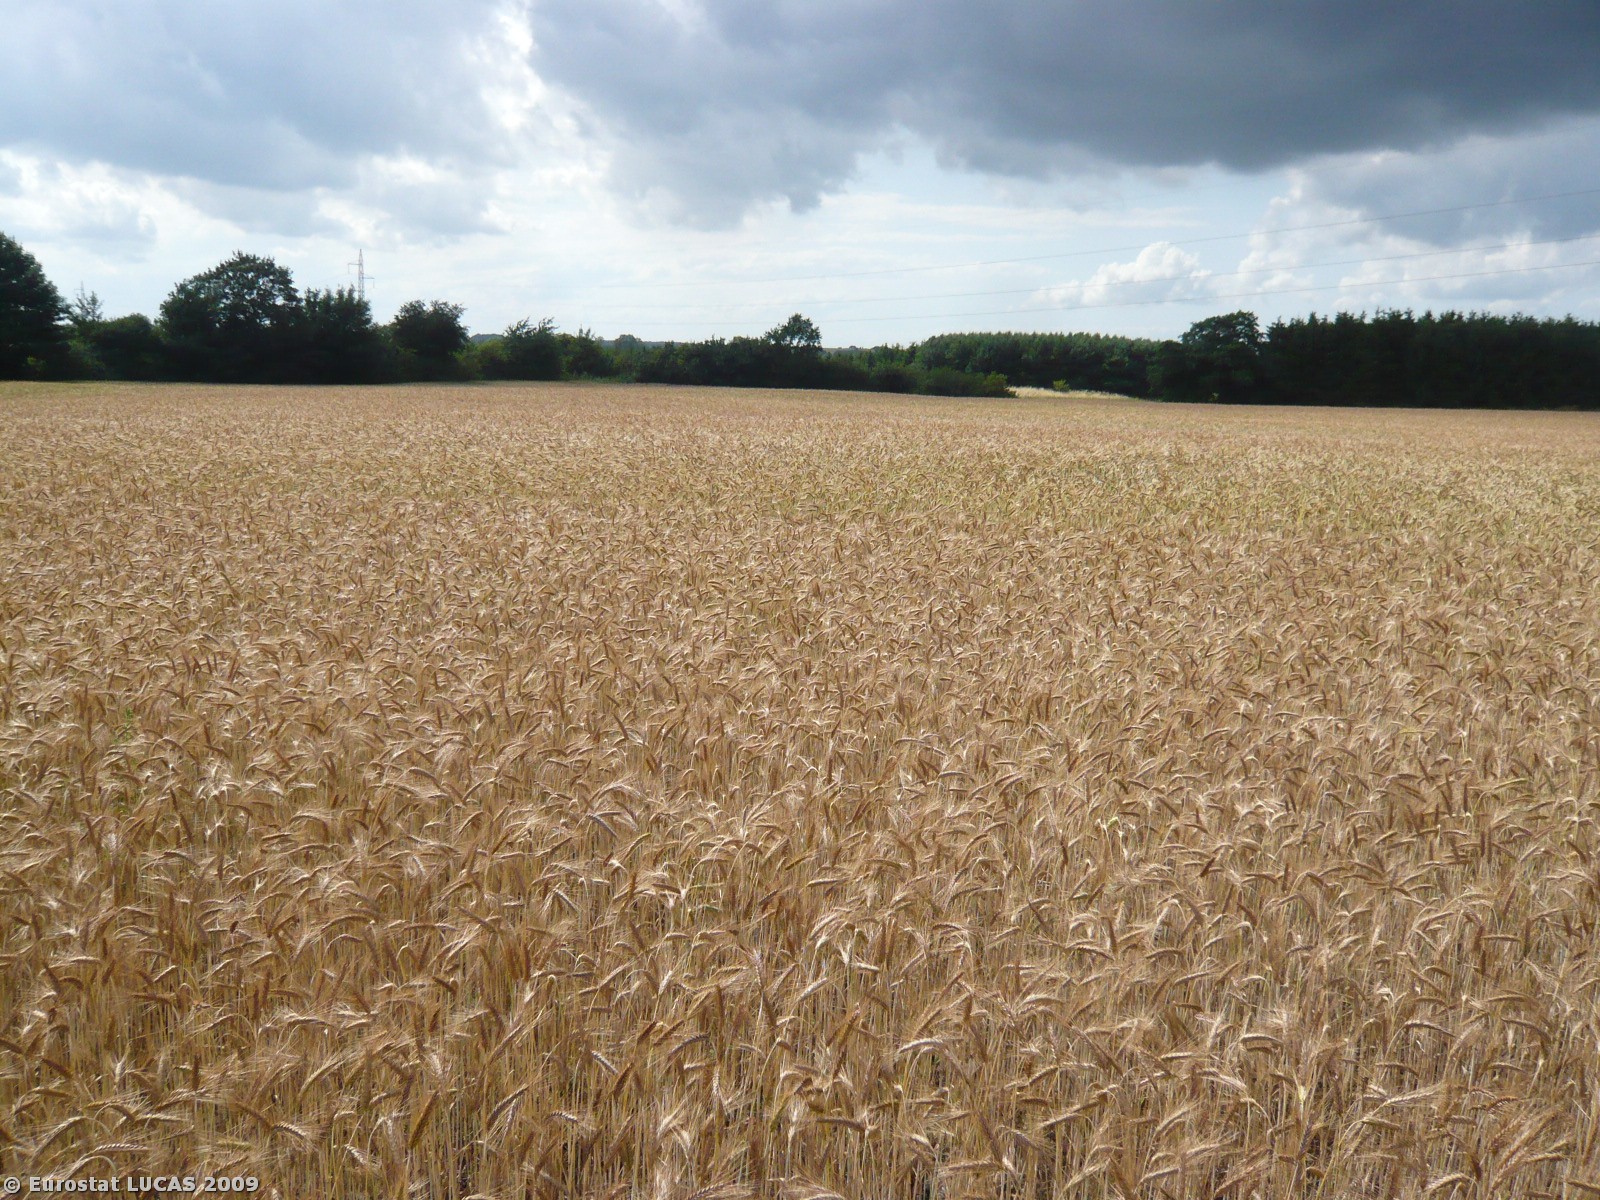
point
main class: Cropland
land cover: Barley
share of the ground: > 75 %
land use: Agriculture (excluding fallow land and kitchen gardens)
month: July
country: DK
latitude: 55.5306
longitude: 11.5987
